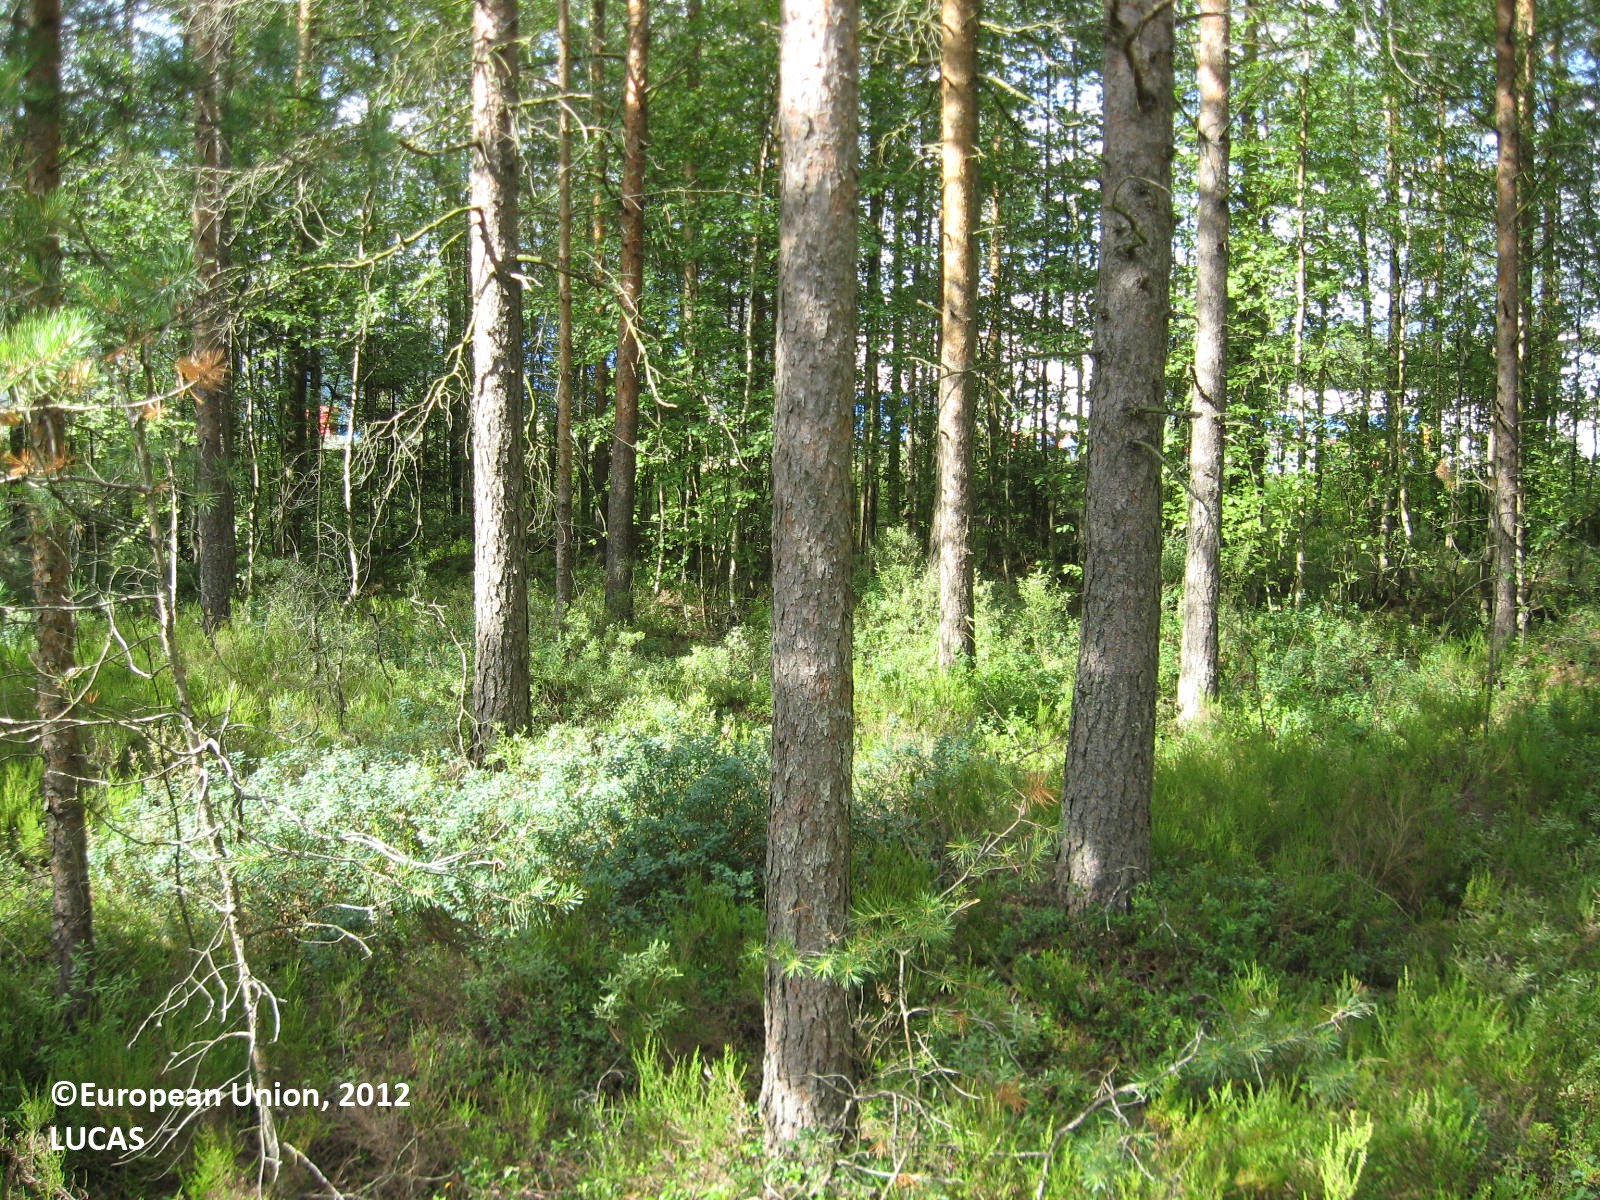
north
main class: Woodland
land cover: Pine dominated coniferous woodland
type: boreal forest
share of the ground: > 75 %
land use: Forestry
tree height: > 5 m
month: July
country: FI
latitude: 61.9789
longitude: 22.2876
